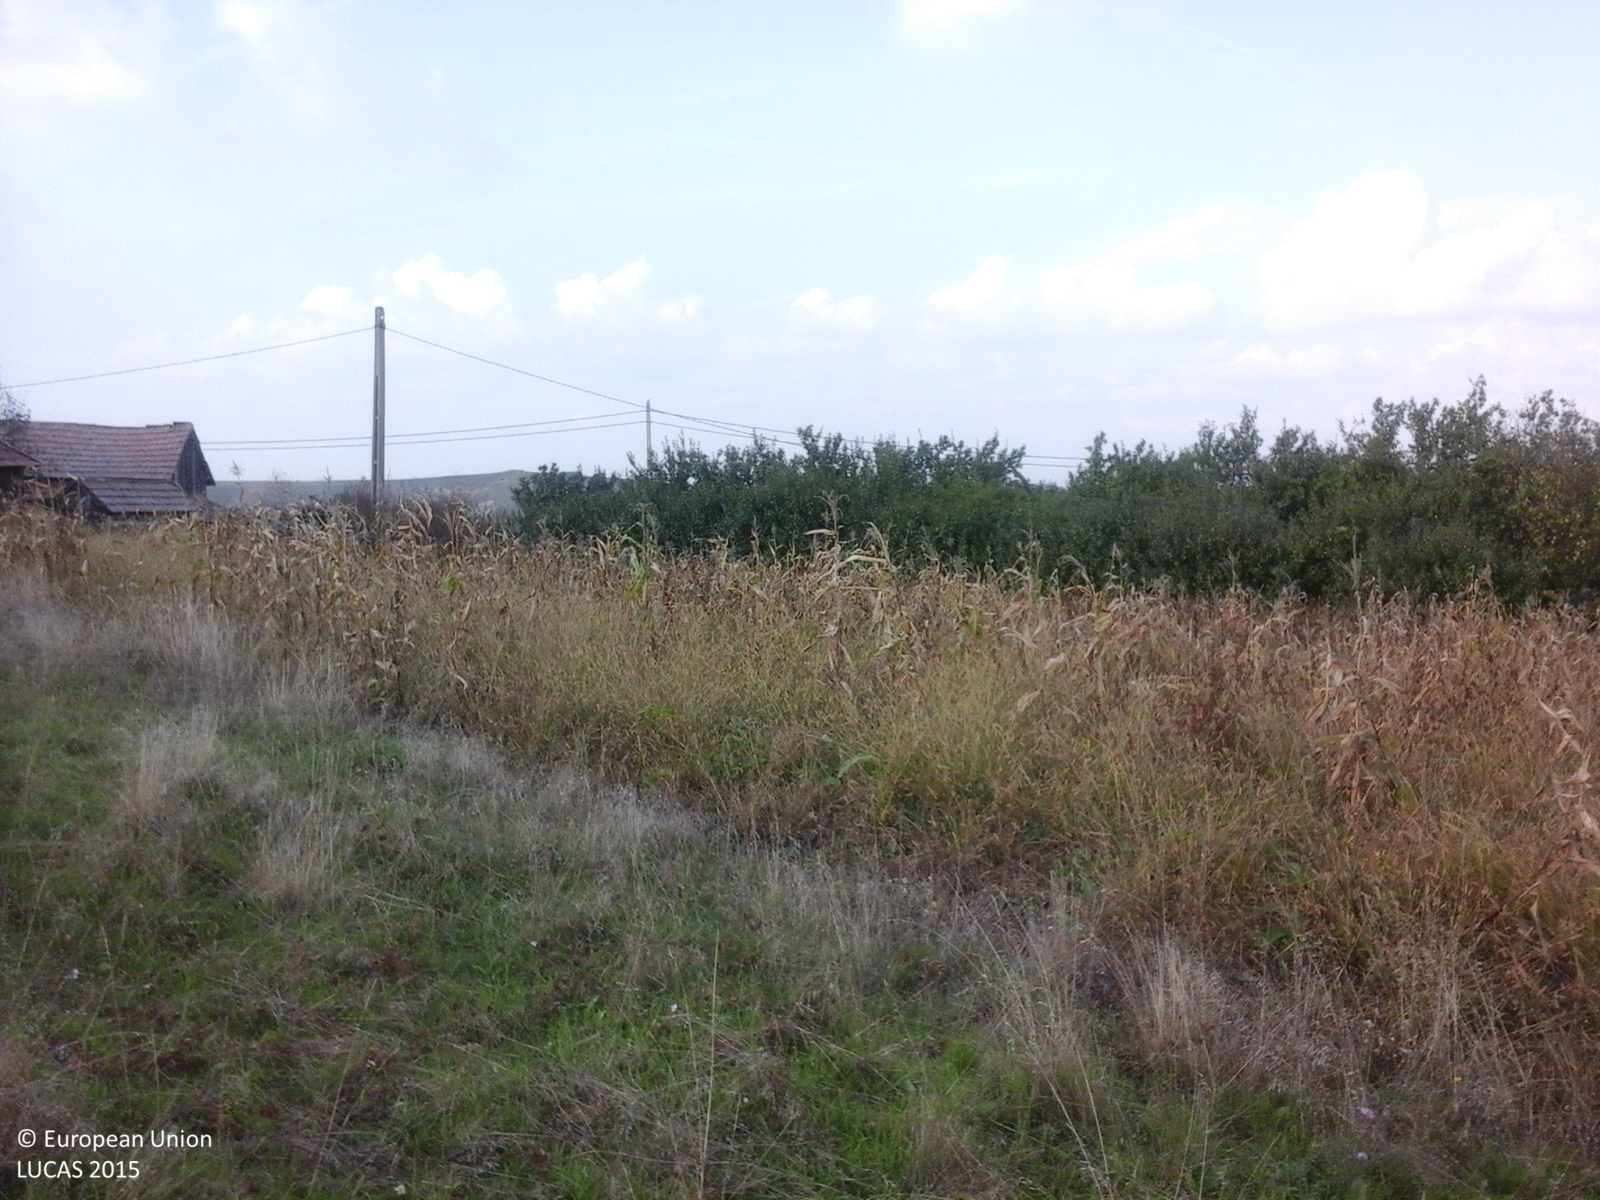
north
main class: Grassland
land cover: Grassland without tree/shrub cover
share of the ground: > 75 %
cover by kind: herbaceous plants 100 %
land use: Agriculture (excluding fallow land and kitchen gardens)
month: October
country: RO
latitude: 46.5804
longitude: 24.2408
